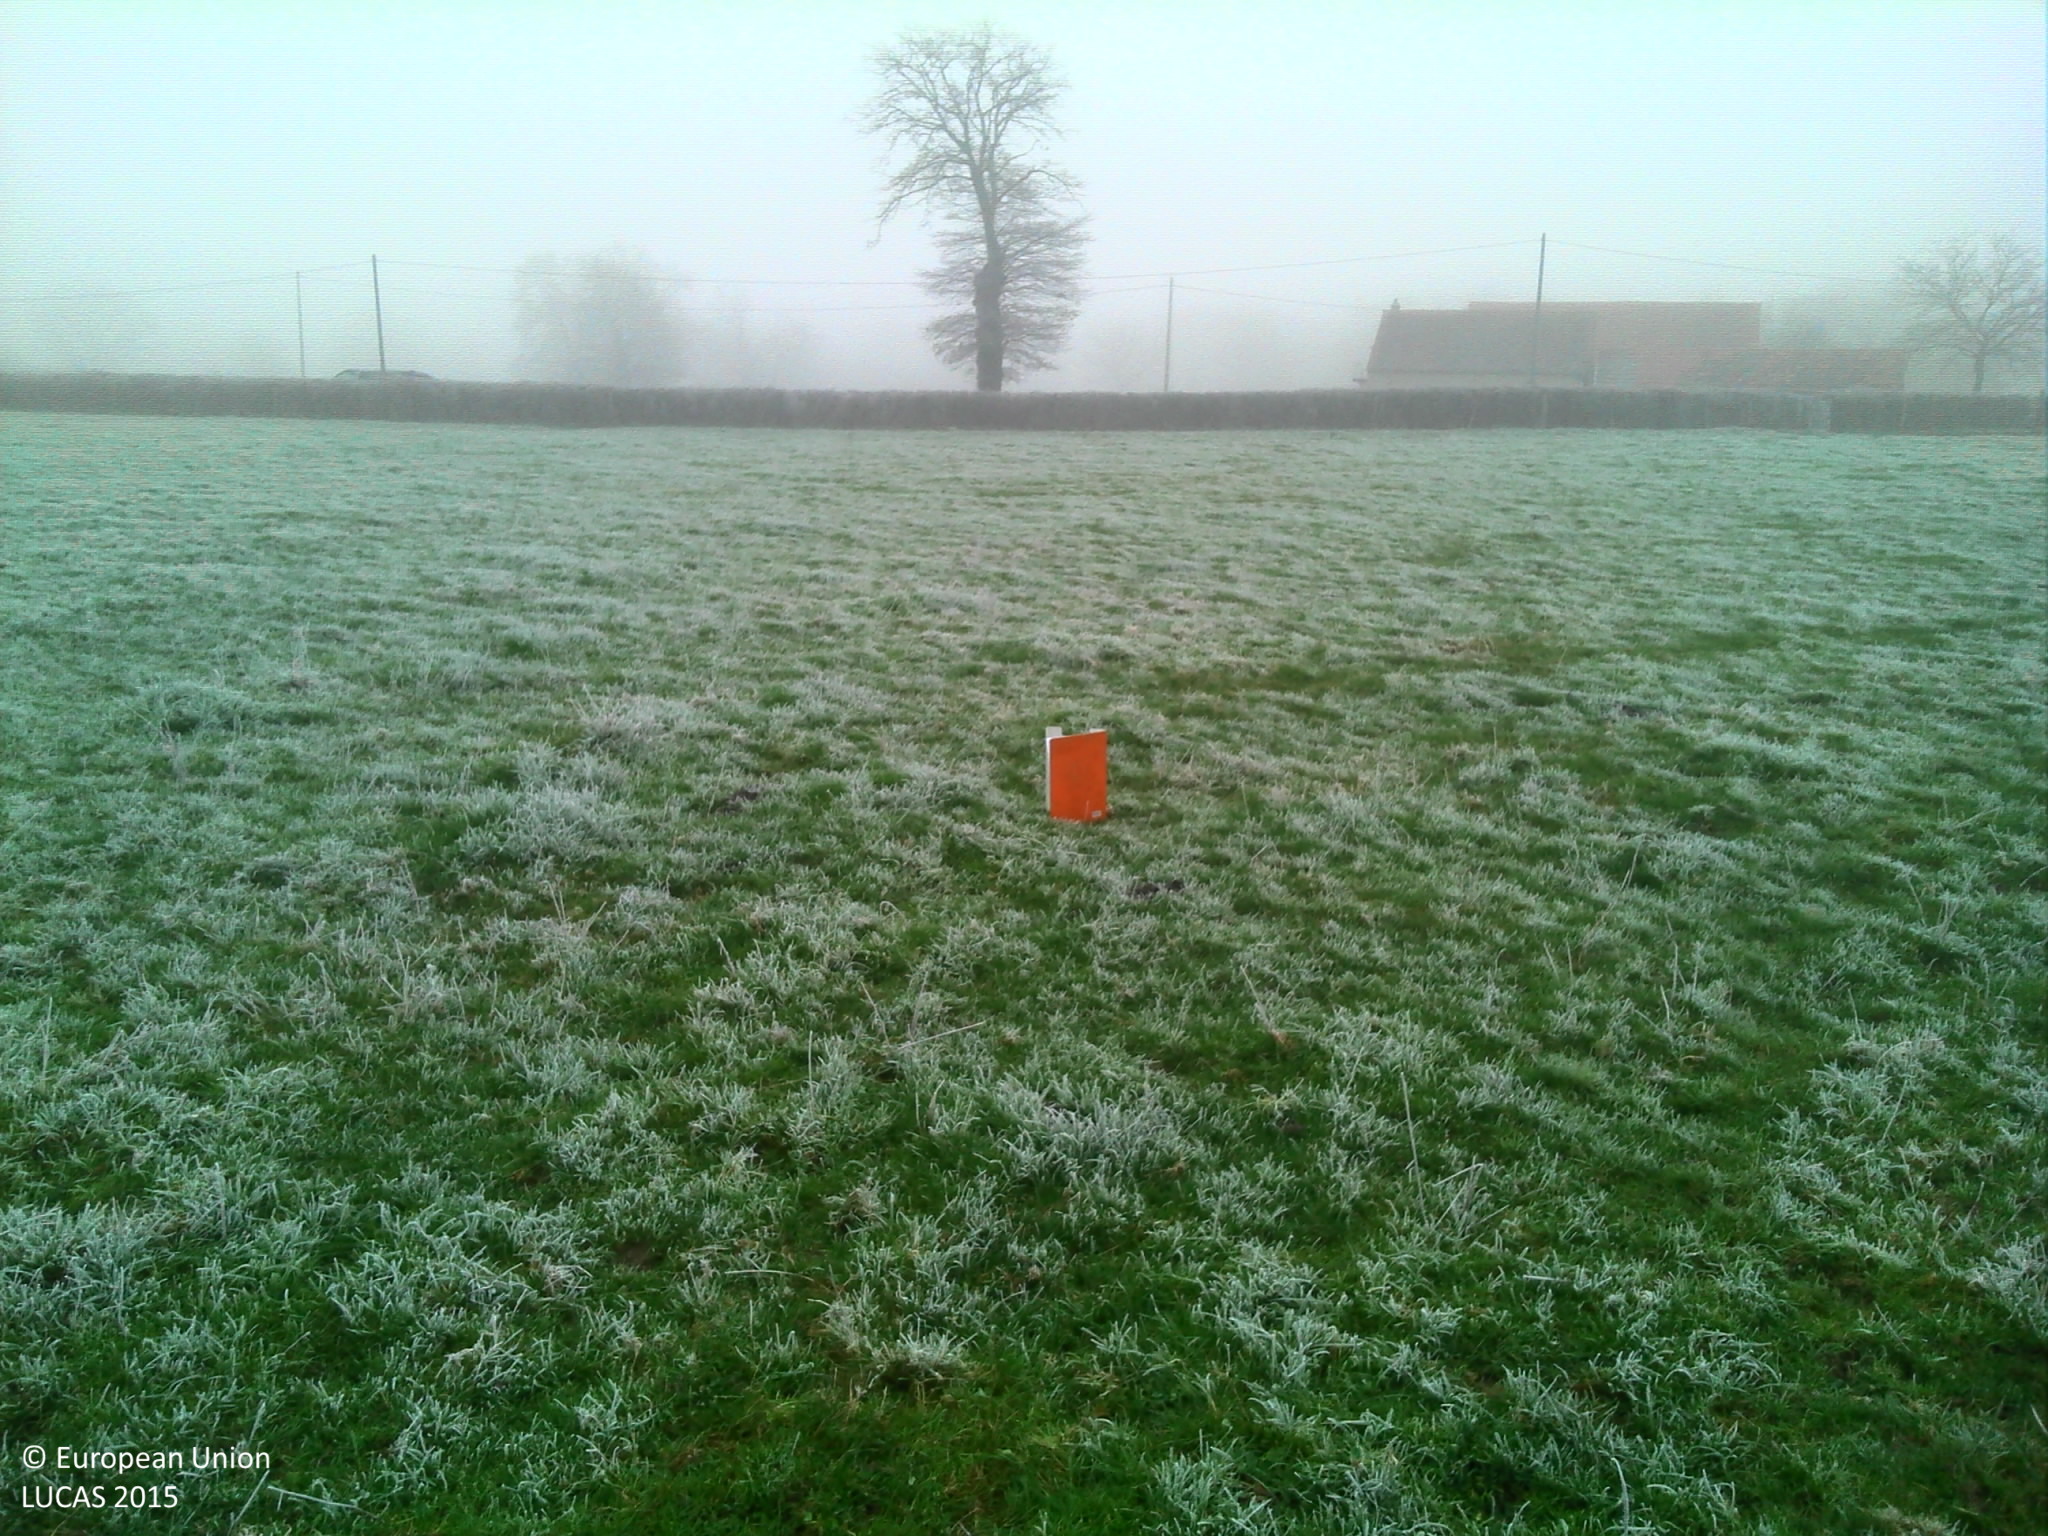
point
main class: Grassland
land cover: Grassland without tree/shrub cover
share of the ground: > 75 %
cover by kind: herbaceous plants 100 %
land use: Agriculture (excluding fallow land and kitchen gardens)
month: November
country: FR
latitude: 46.6135
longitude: 3.6400
